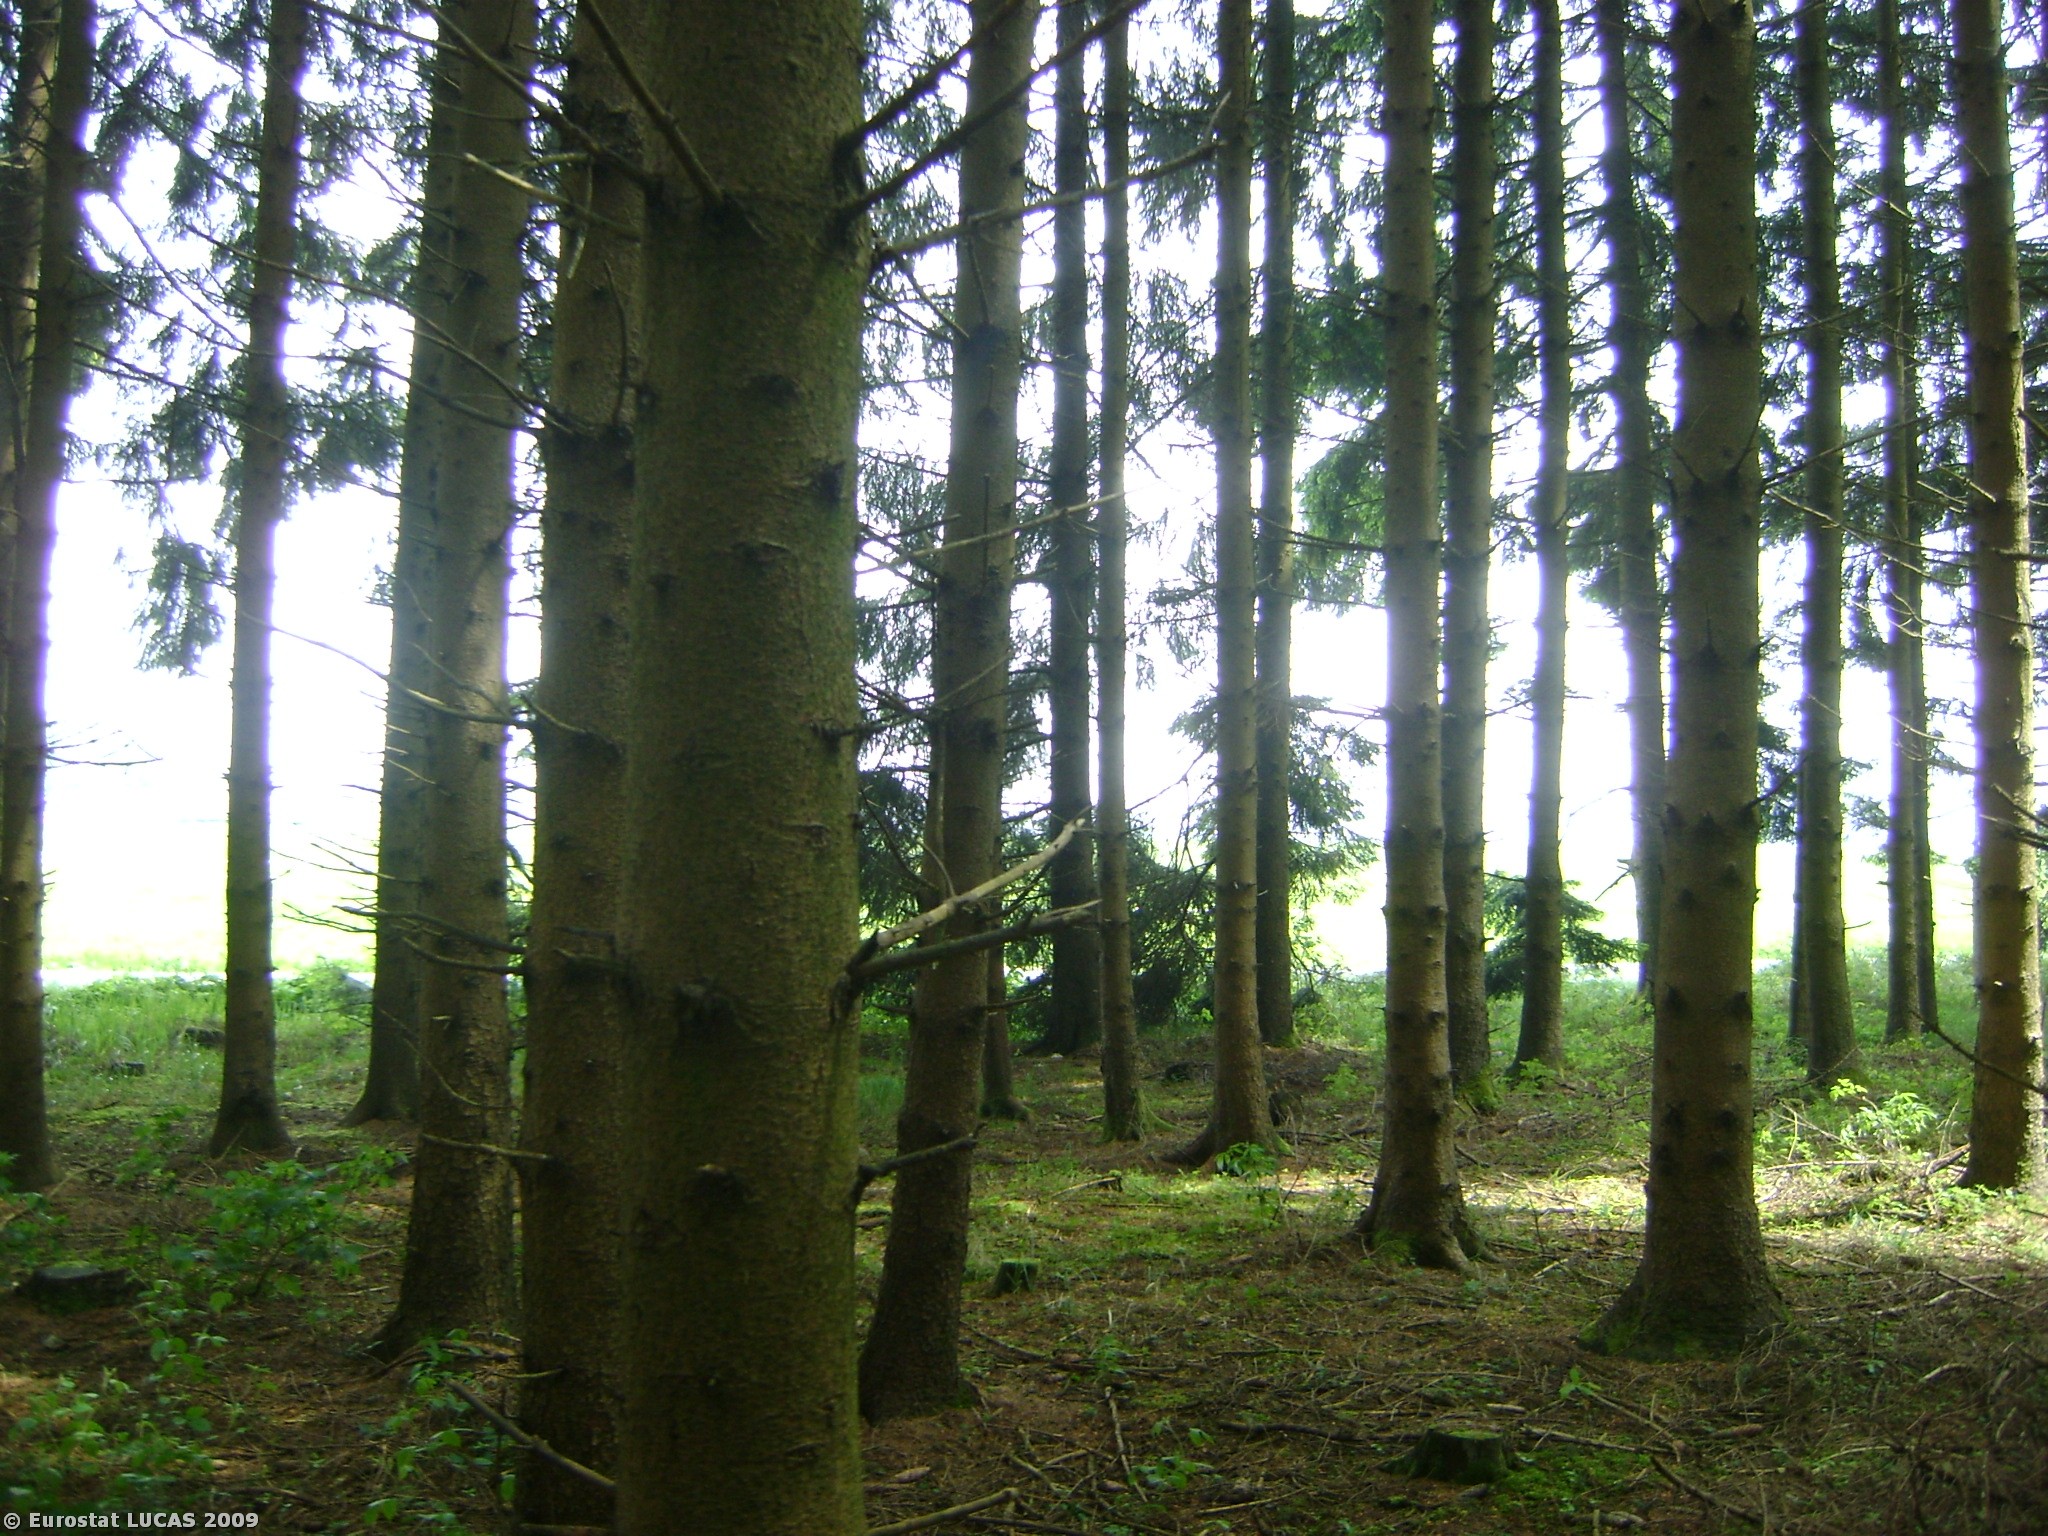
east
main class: Woodland
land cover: Coniferous woodland
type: hemiboreal forest and nemoral coniferous forest and mixed broadleaved-coniferous forest
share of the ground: > 75 %
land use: Forestry
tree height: > 5 m
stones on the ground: < 10 %
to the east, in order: Coniferous woodland; Grass margins; Paved roads, cycling and walking lanes; Grassland without tree/shrub cover; Tracks; Grassland without tree/shrub cover; Tracks; Grassland without tree/shrub cover
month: May
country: AT
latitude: 47.9782
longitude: 13.2275
